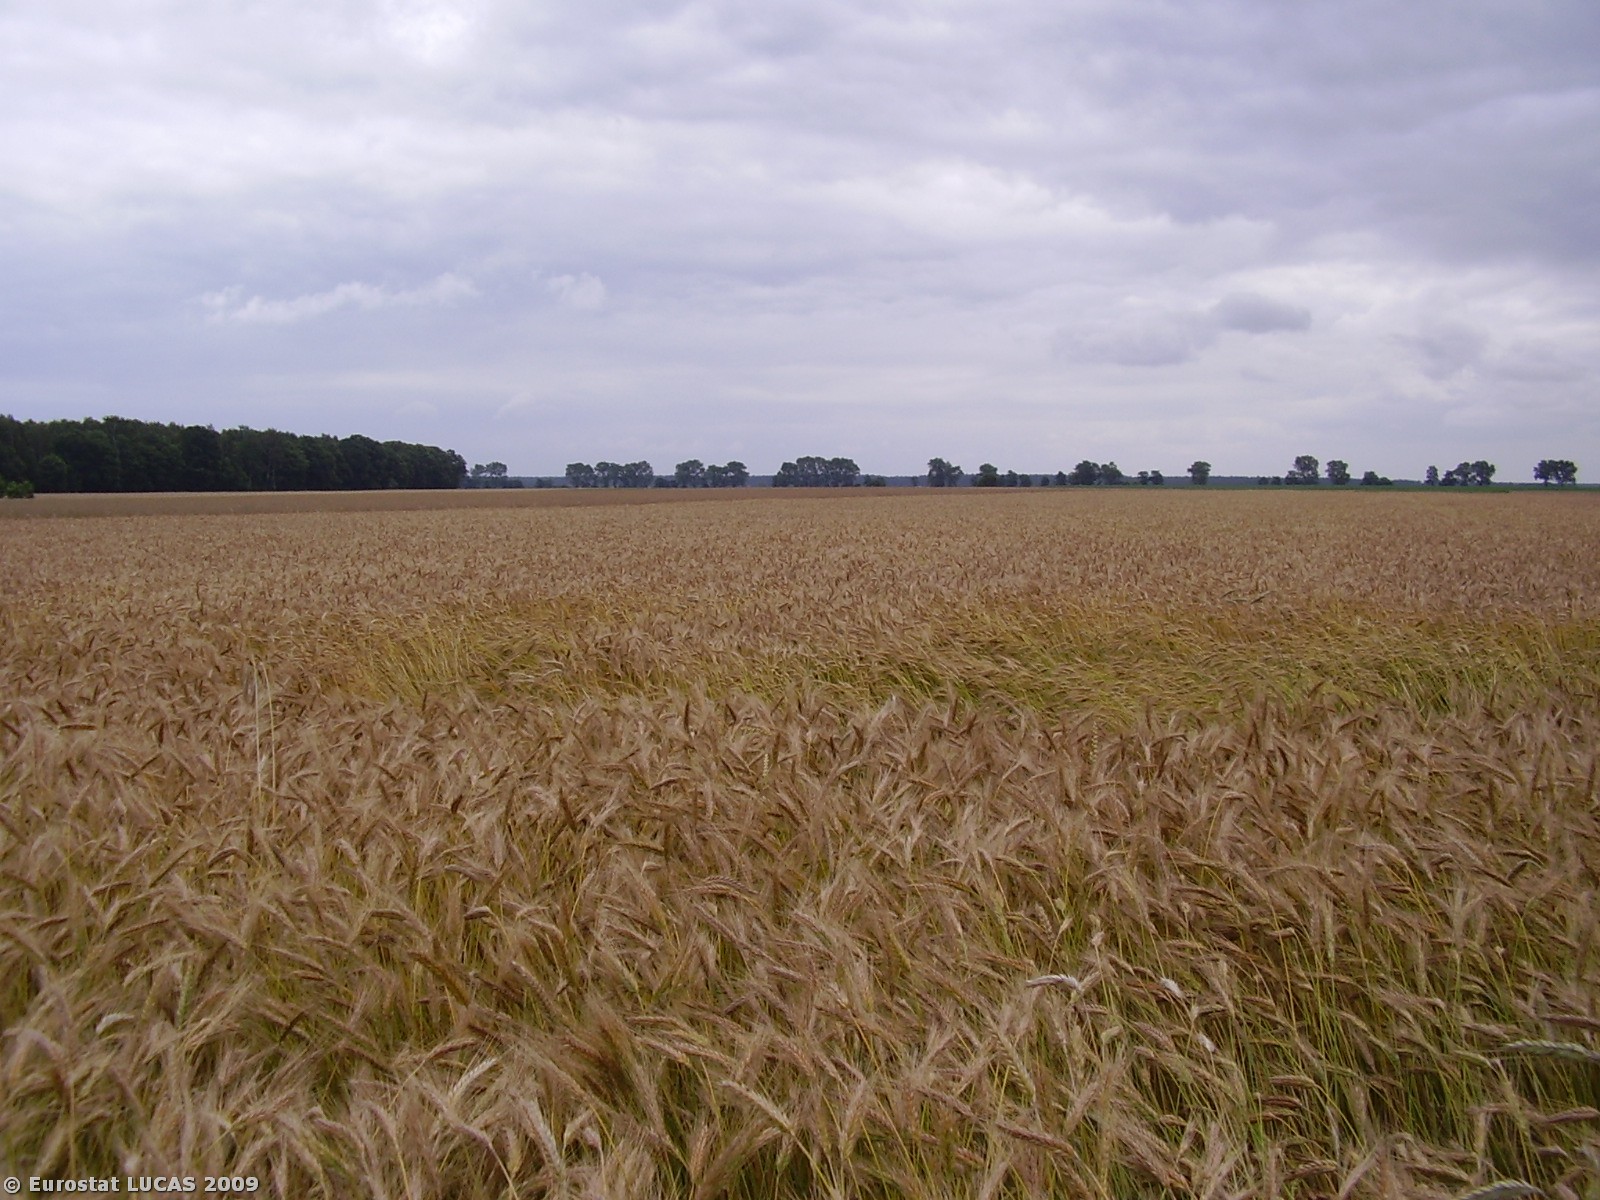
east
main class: Cropland
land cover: Triticale
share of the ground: > 75 %
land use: Agriculture (excluding fallow land and kitchen gardens)
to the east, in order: Triticale; Rape and turnip rape
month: July
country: PL
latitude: 51.2259
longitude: 17.6748
